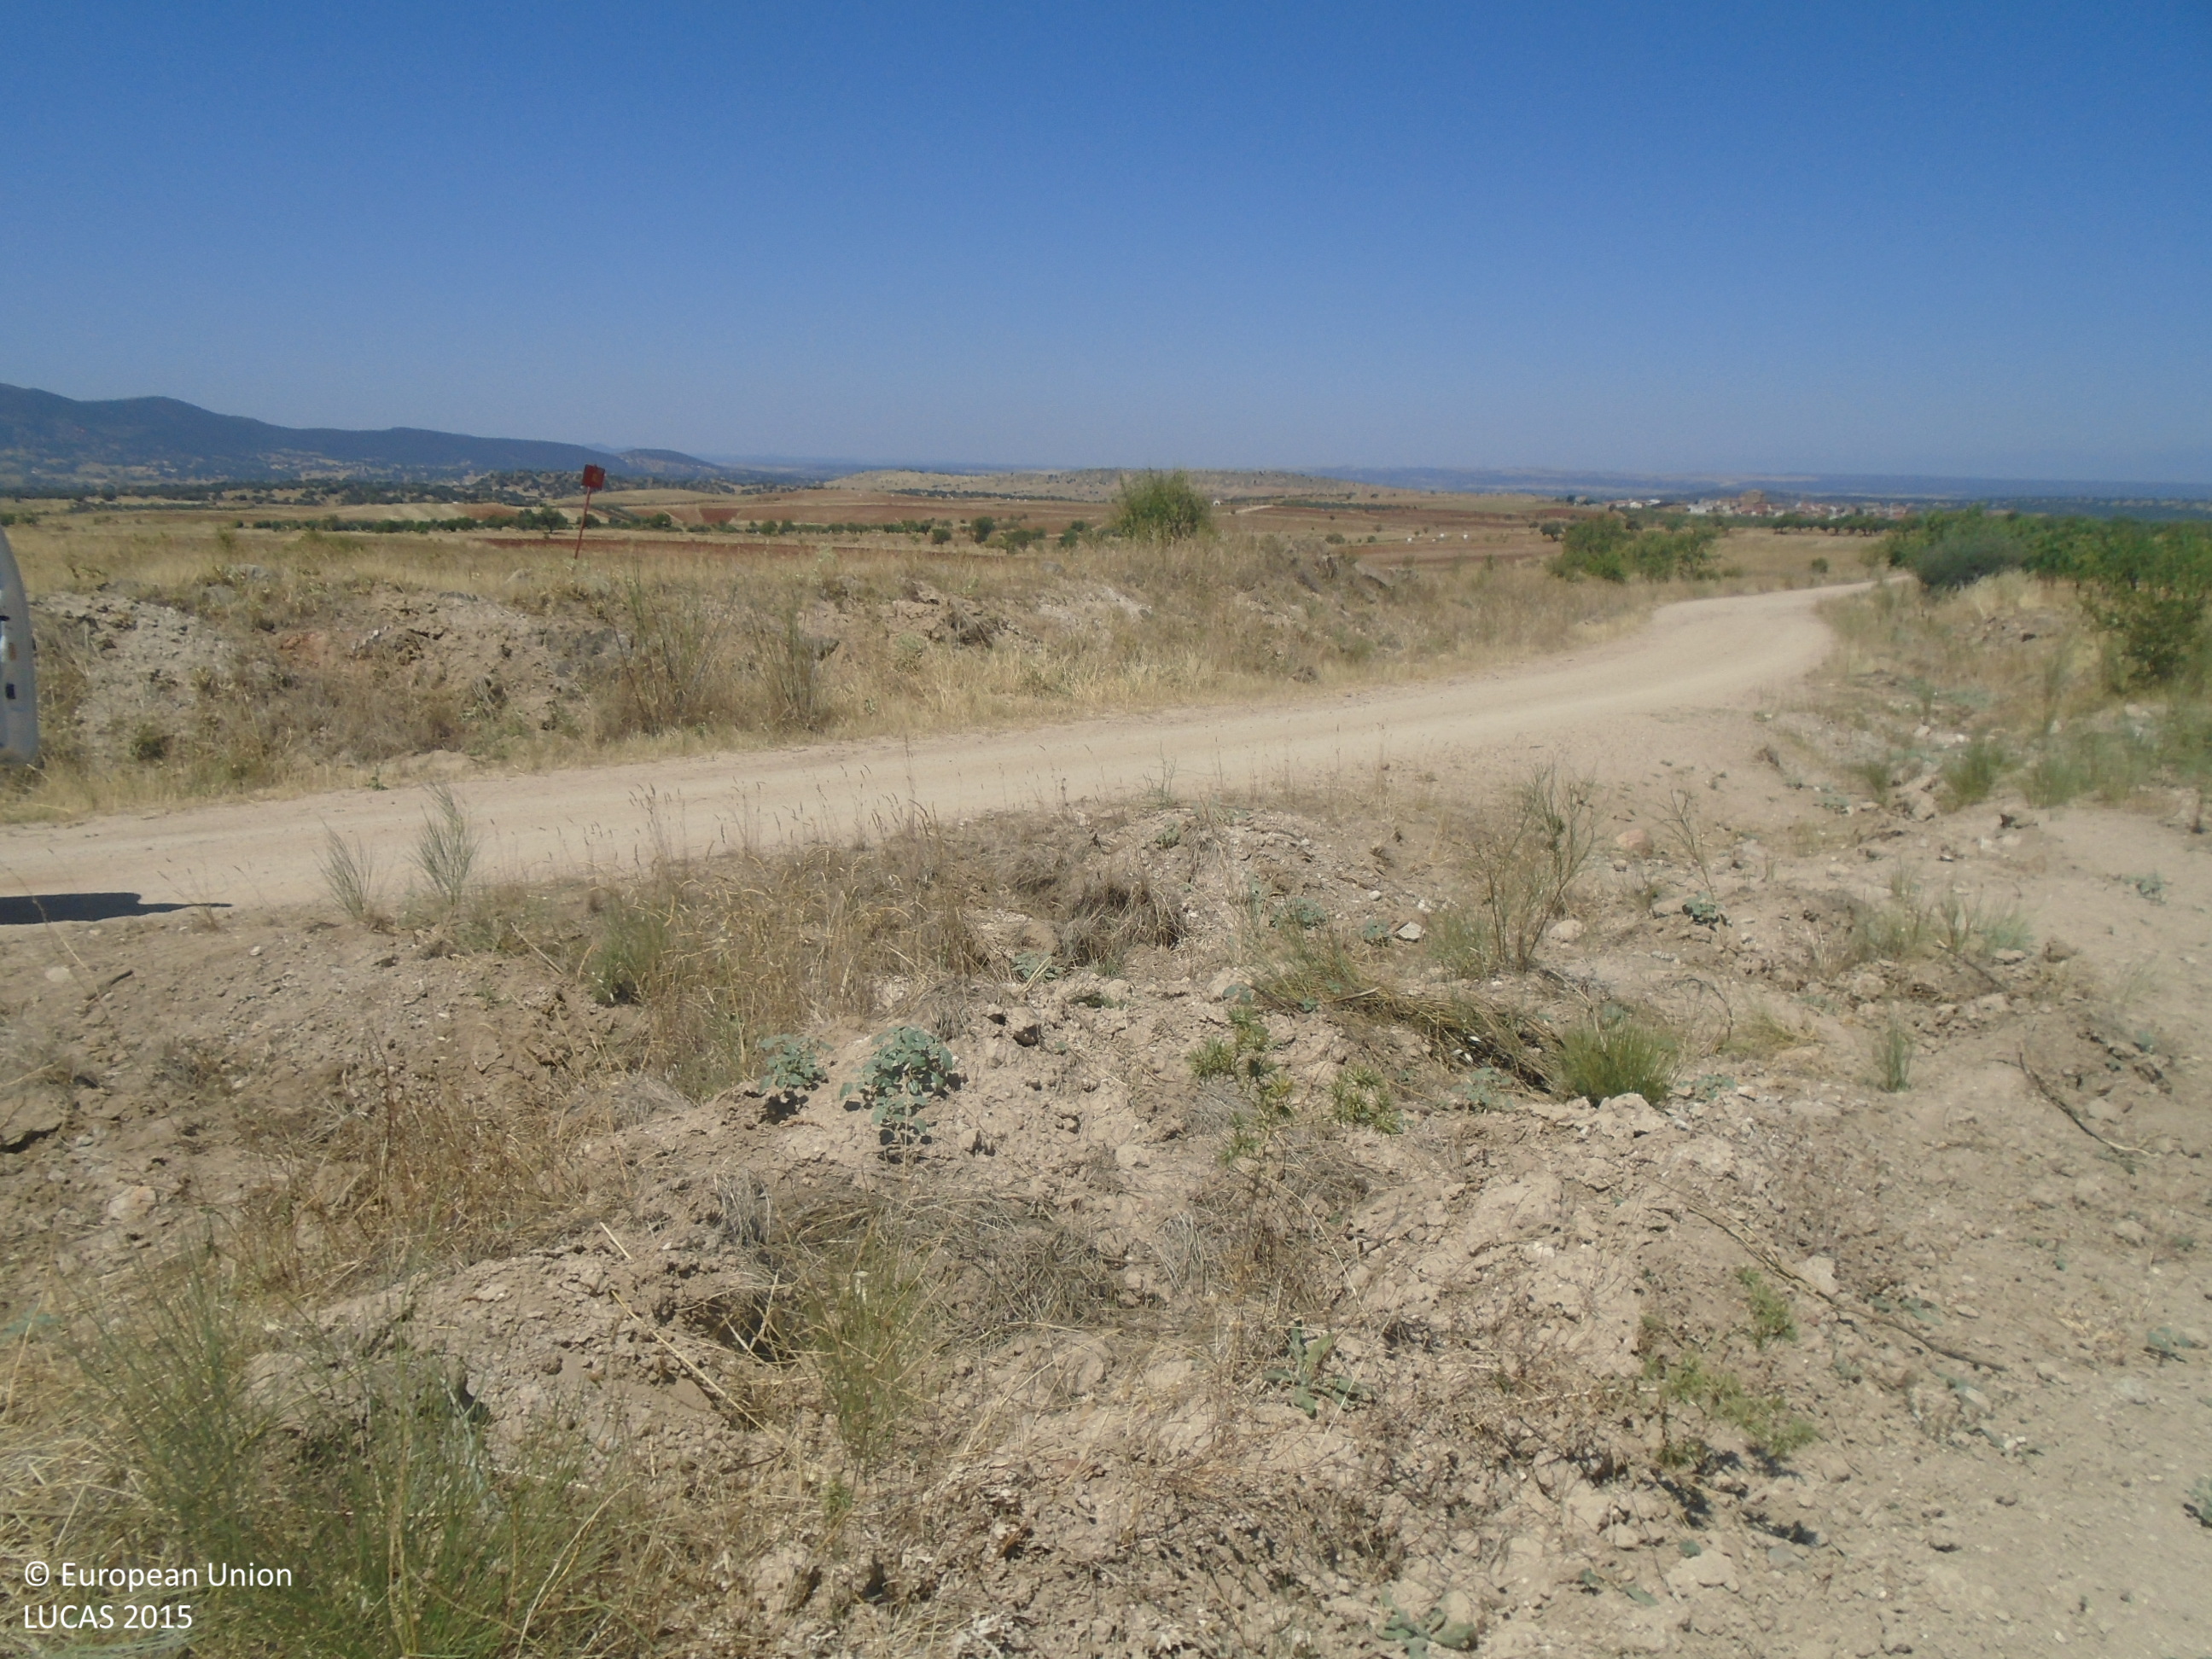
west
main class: Grassland
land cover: Spontaneously vegetated surfaces
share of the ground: > 75 %
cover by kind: herbaceous plants 90 %, unconsolidated bare surface 10 %
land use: Agriculture (excluding fallow land and kitchen gardens)
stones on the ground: < 10 %
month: July
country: ES
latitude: 39.7500
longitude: -4.9977
